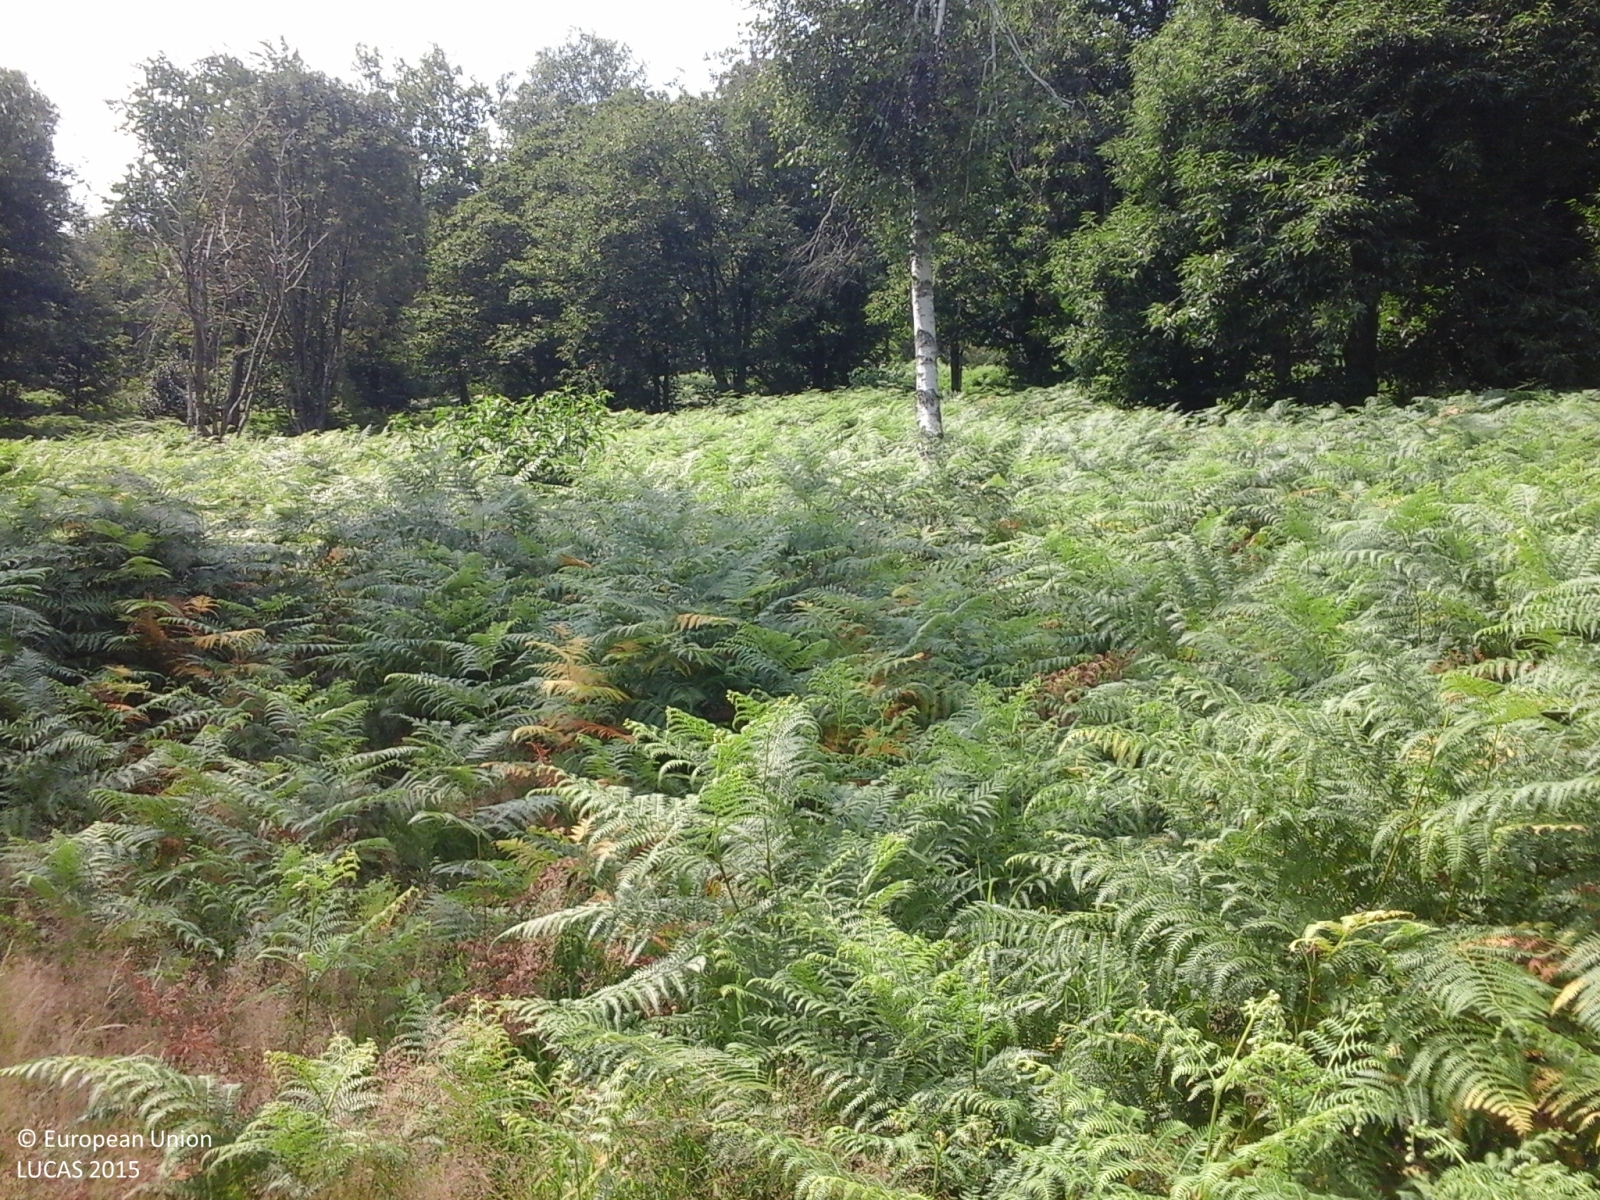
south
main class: Grassland
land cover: Grassland with sparse tree/shrub cover
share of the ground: > 75 %
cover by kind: herbaceous plants 95 %, broadleaved forest trees 5 %
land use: Semi-natural and natural areas not in use
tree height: > 5 m
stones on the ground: < 10 %
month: July
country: IT
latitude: 45.9652
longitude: 8.7243
